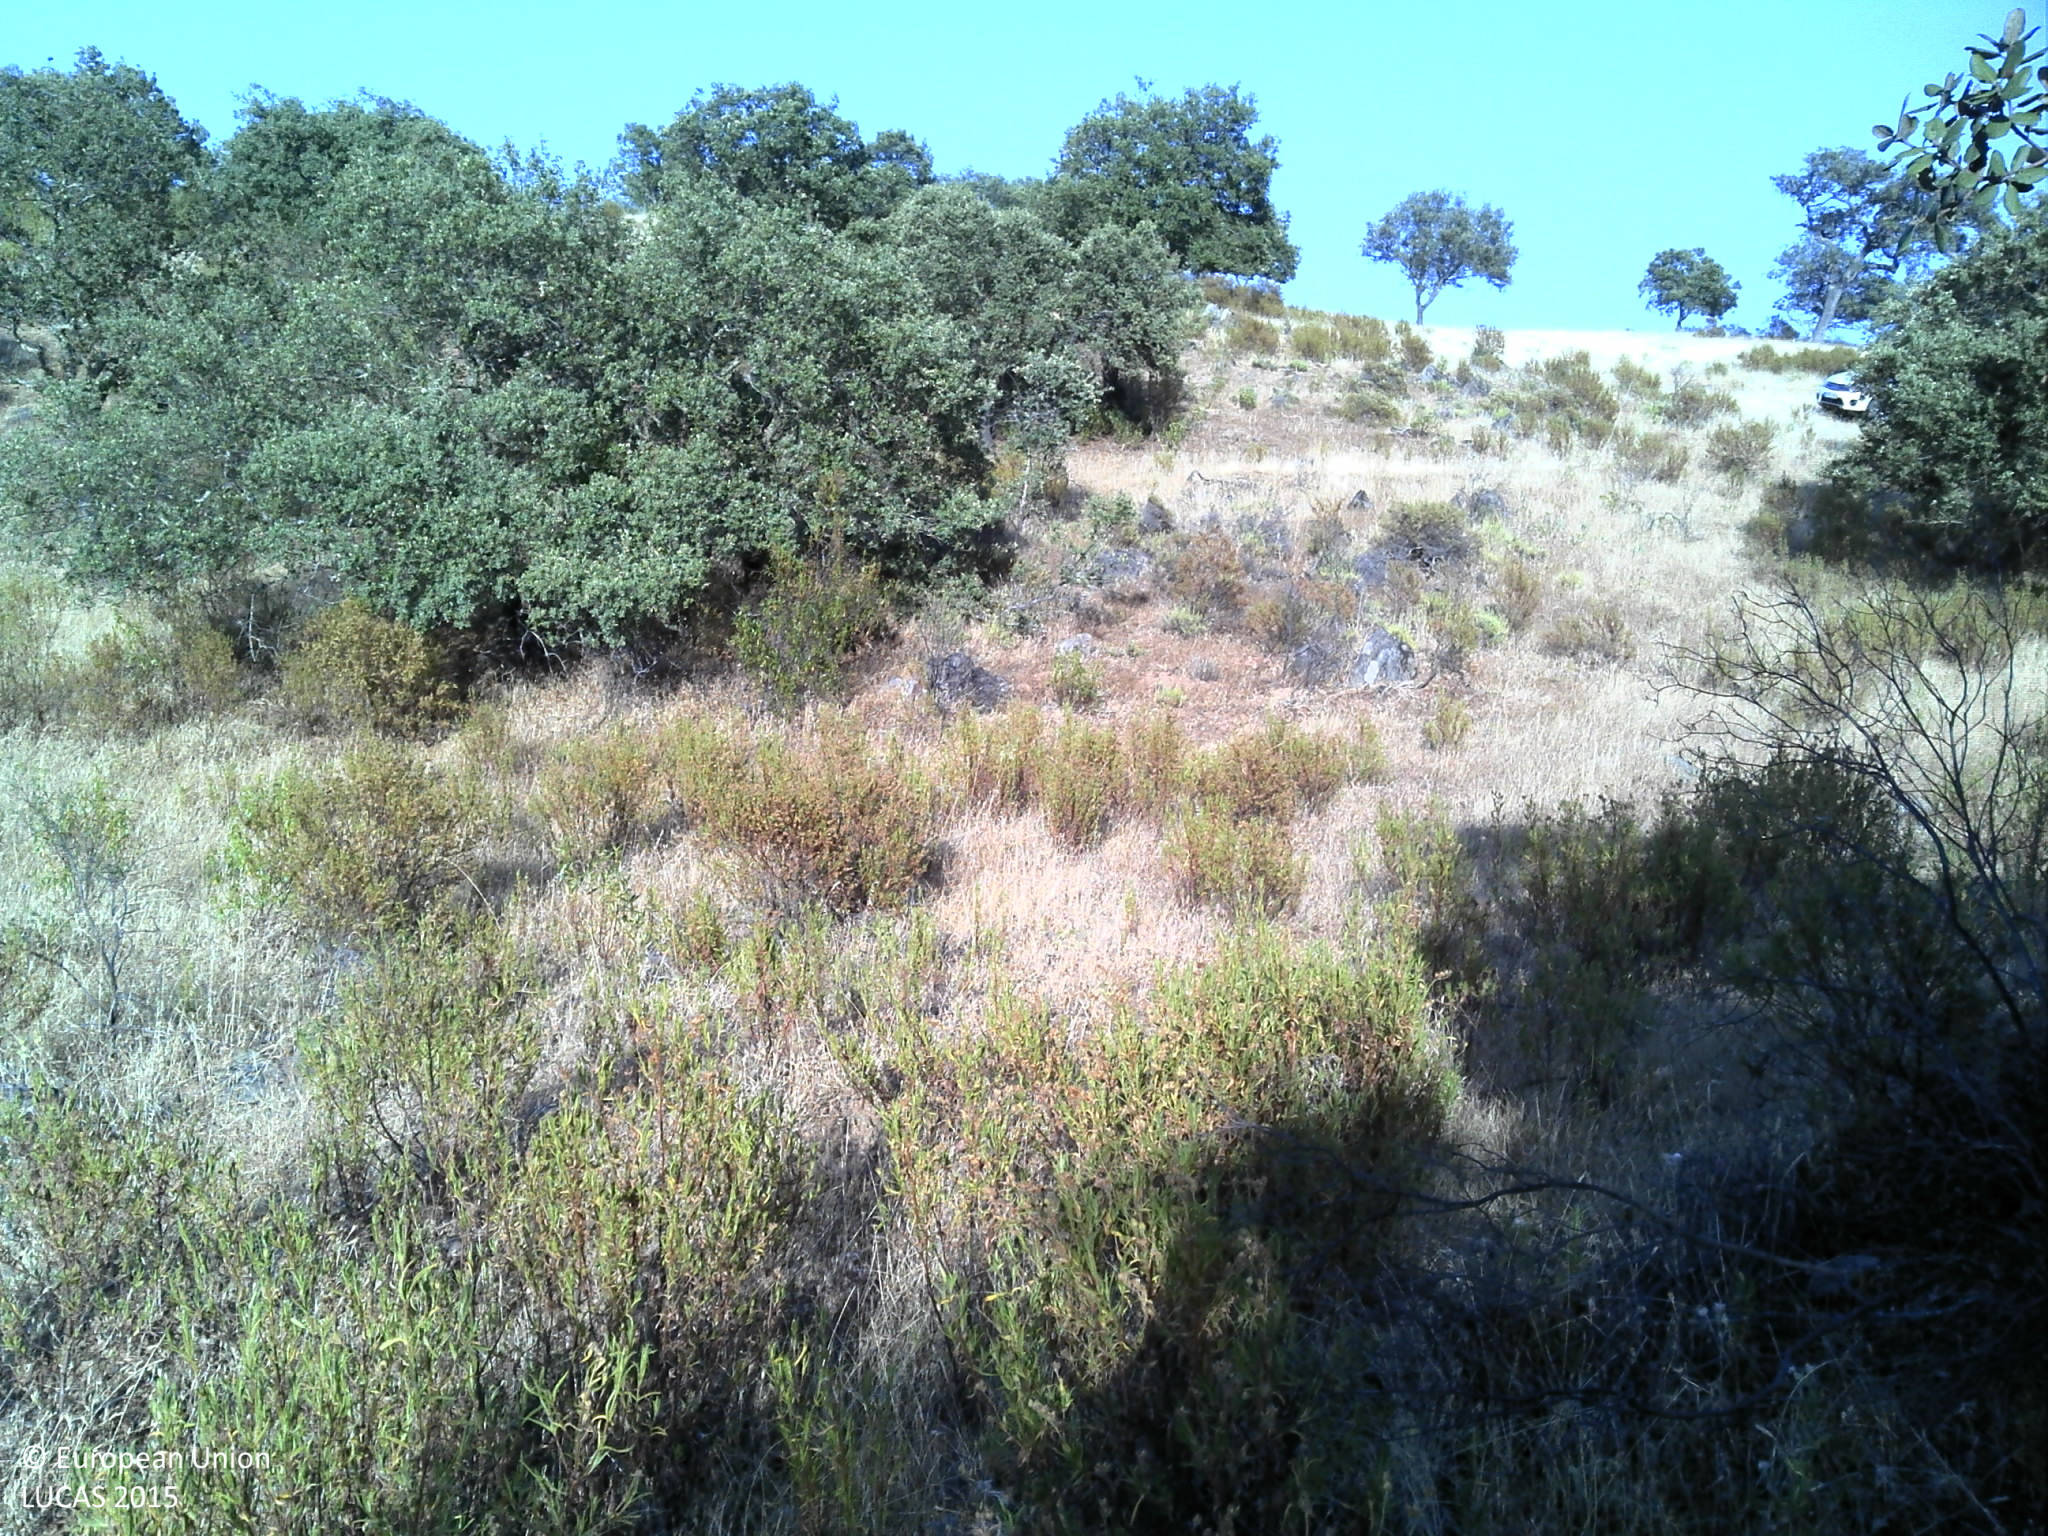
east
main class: Woodland
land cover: Broadleaved woodland
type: broadleaved evergreen forest
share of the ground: 25 - 50 %
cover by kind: broadleaved forest trees 50 %, shrubs 25 %, herbaceous plants 15 %, unconsolidated bare surface 10 %
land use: Forestry
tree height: < 5 m
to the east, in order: Broadleaved woodland; Fences; Grassland without tree/shrub cover; Broadleaved woodland; Shrubland without tree cover; Rivers and streams; Shrubland without tree cover; Broadleaved woodland
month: June
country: PT
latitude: 37.5942
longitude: -7.5791
